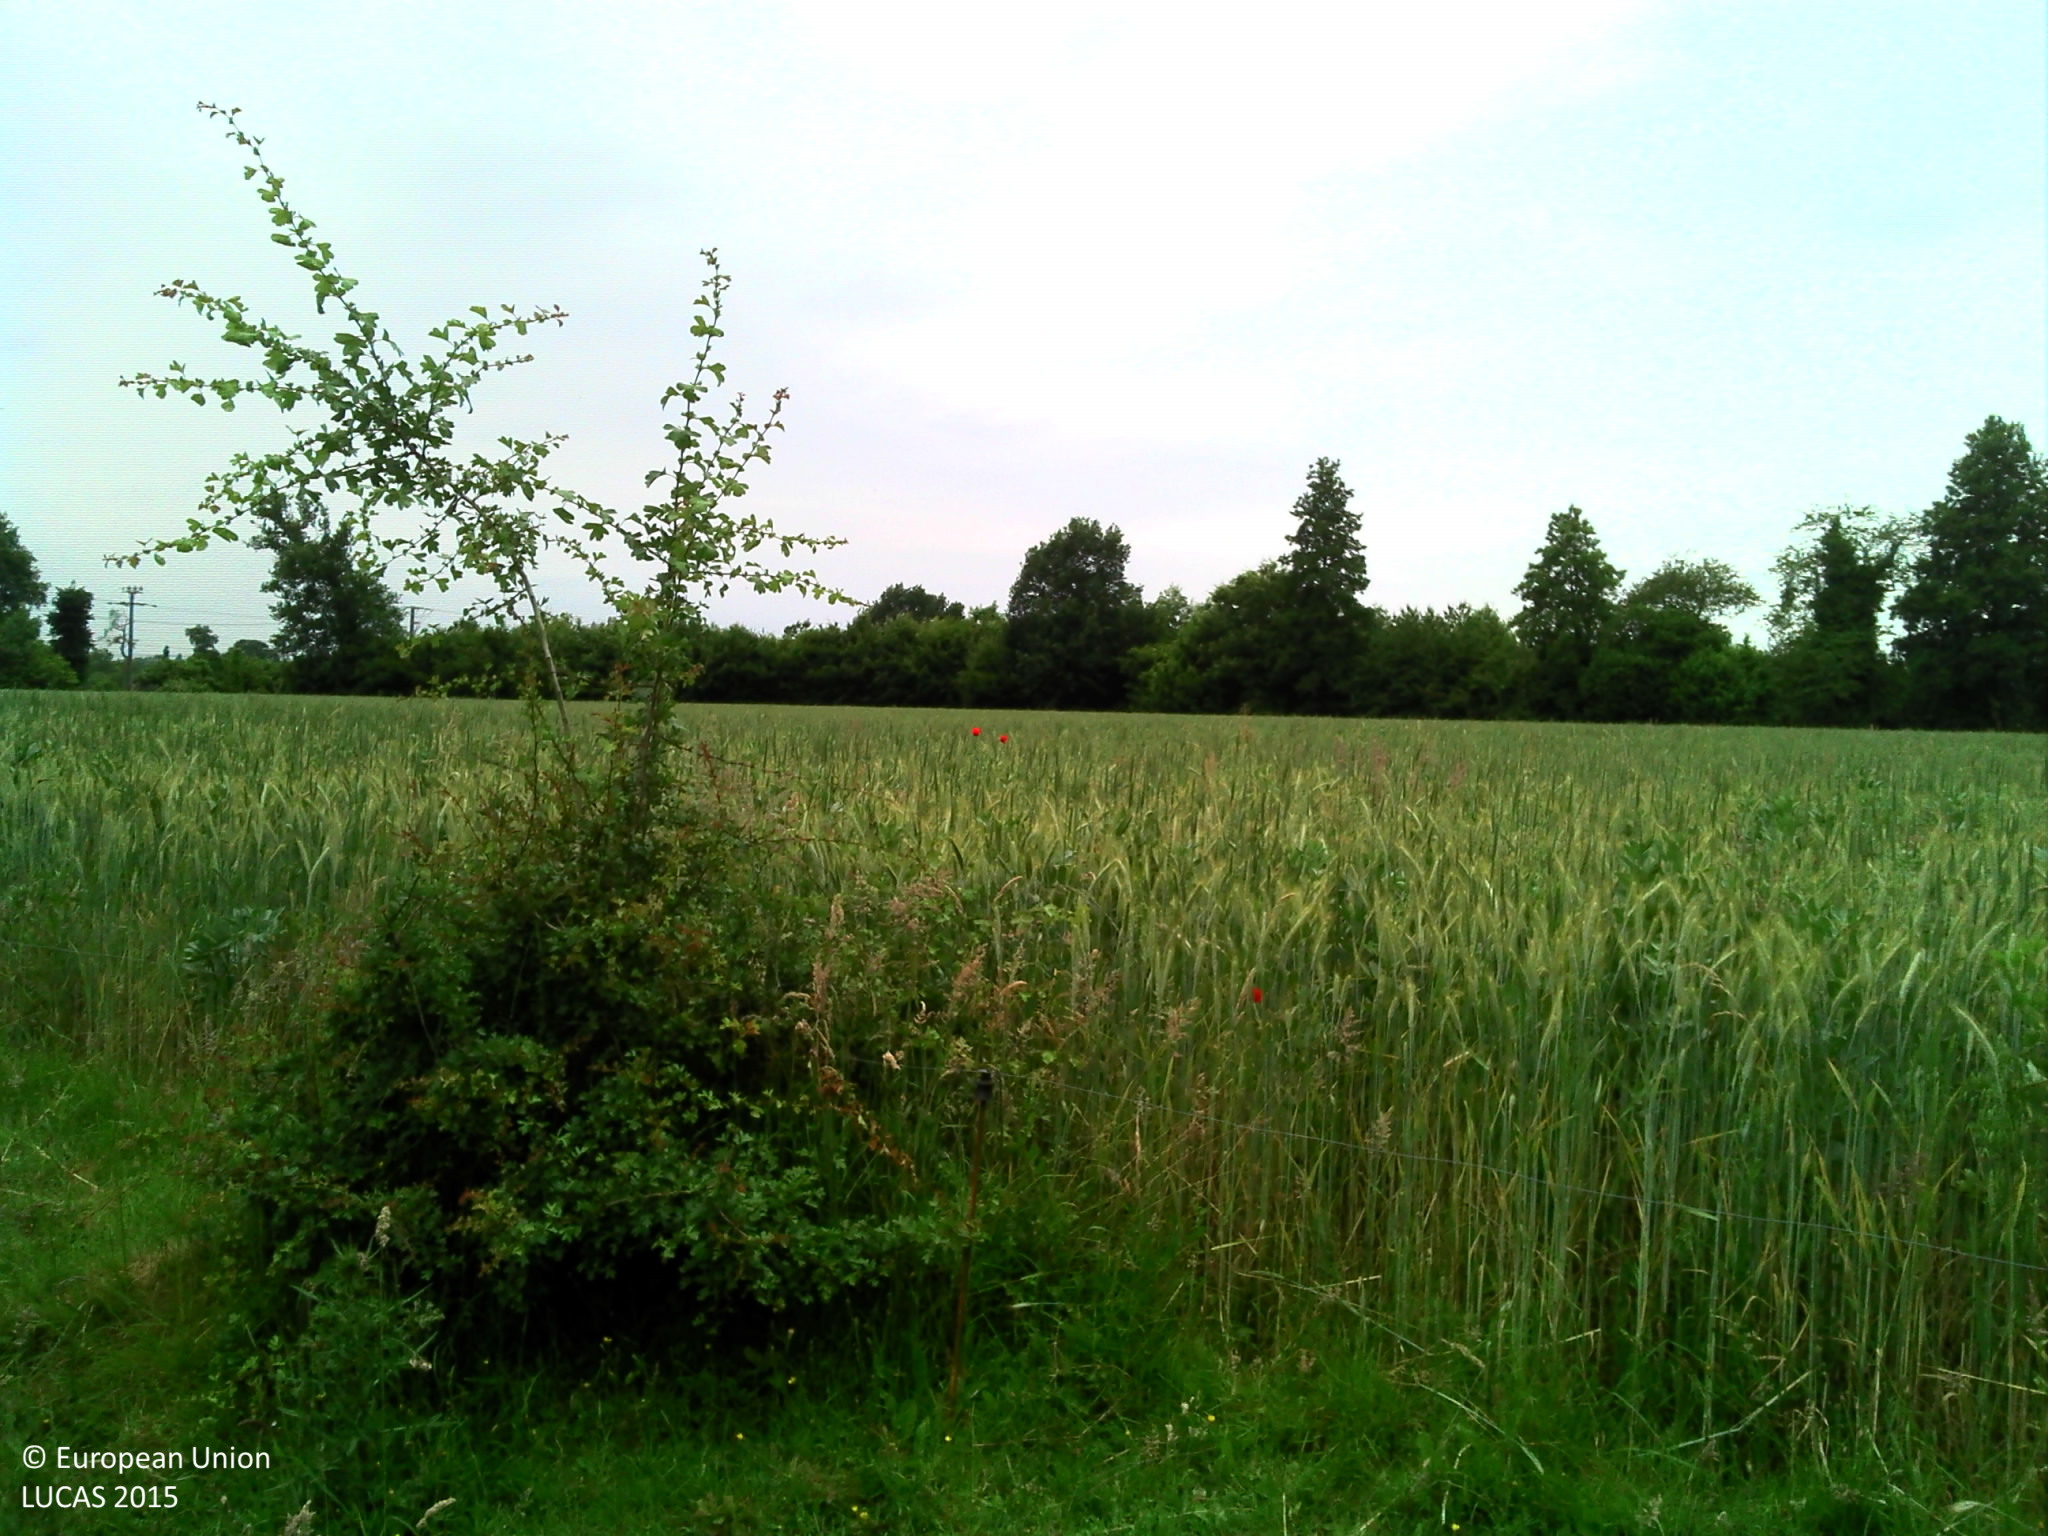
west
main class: Cropland
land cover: Apple fruit
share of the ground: 10 - 25 %
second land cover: Grassland without tree/shrub cover
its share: > 75 %
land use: Agriculture (excluding fallow land and kitchen gardens)
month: June
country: FR
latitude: 48.1668
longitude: -1.6517
